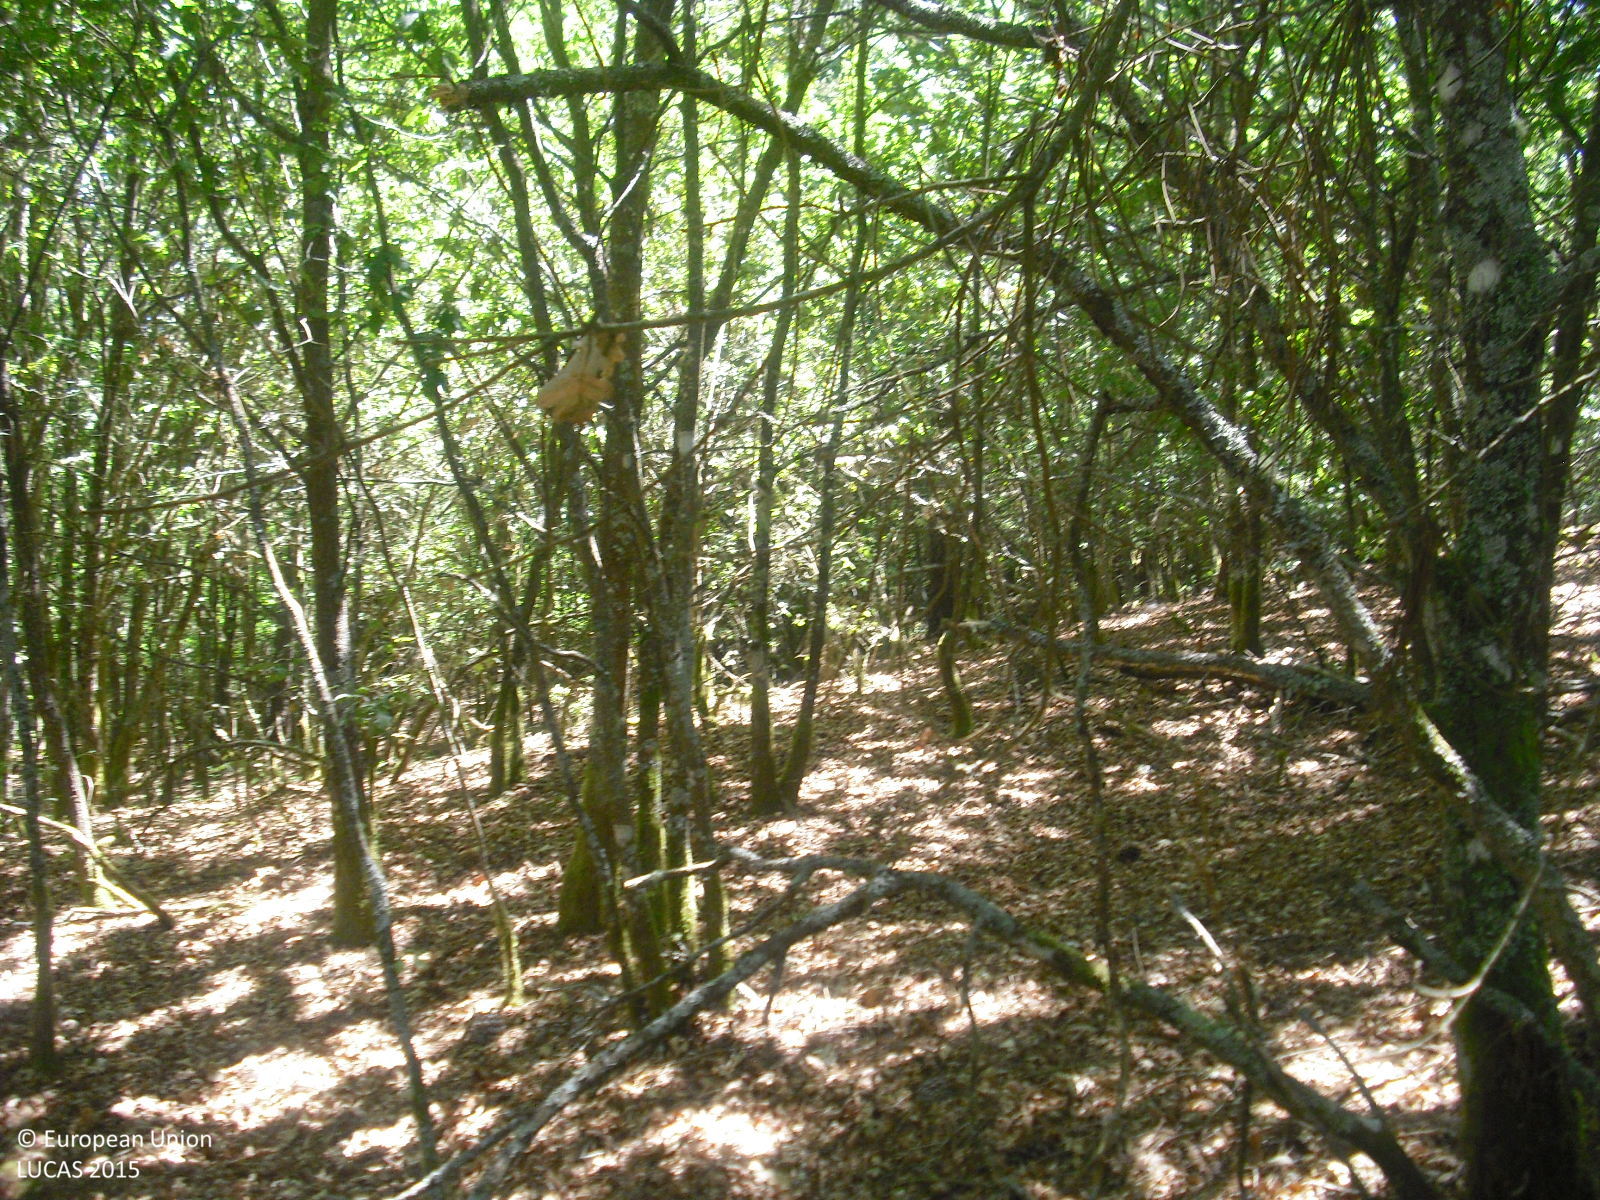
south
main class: Woodland
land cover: Pine dominated mixed woodland
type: hemiboreal forest and nemoral coniferous forest and mixed broadleaved-coniferous forest
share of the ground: > 75 %
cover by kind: broadleaved forest trees 60 %, coniferous forest trees 40 %
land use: Forestry
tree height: > 5 m
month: June
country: ES
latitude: 42.4867
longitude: -7.7781
